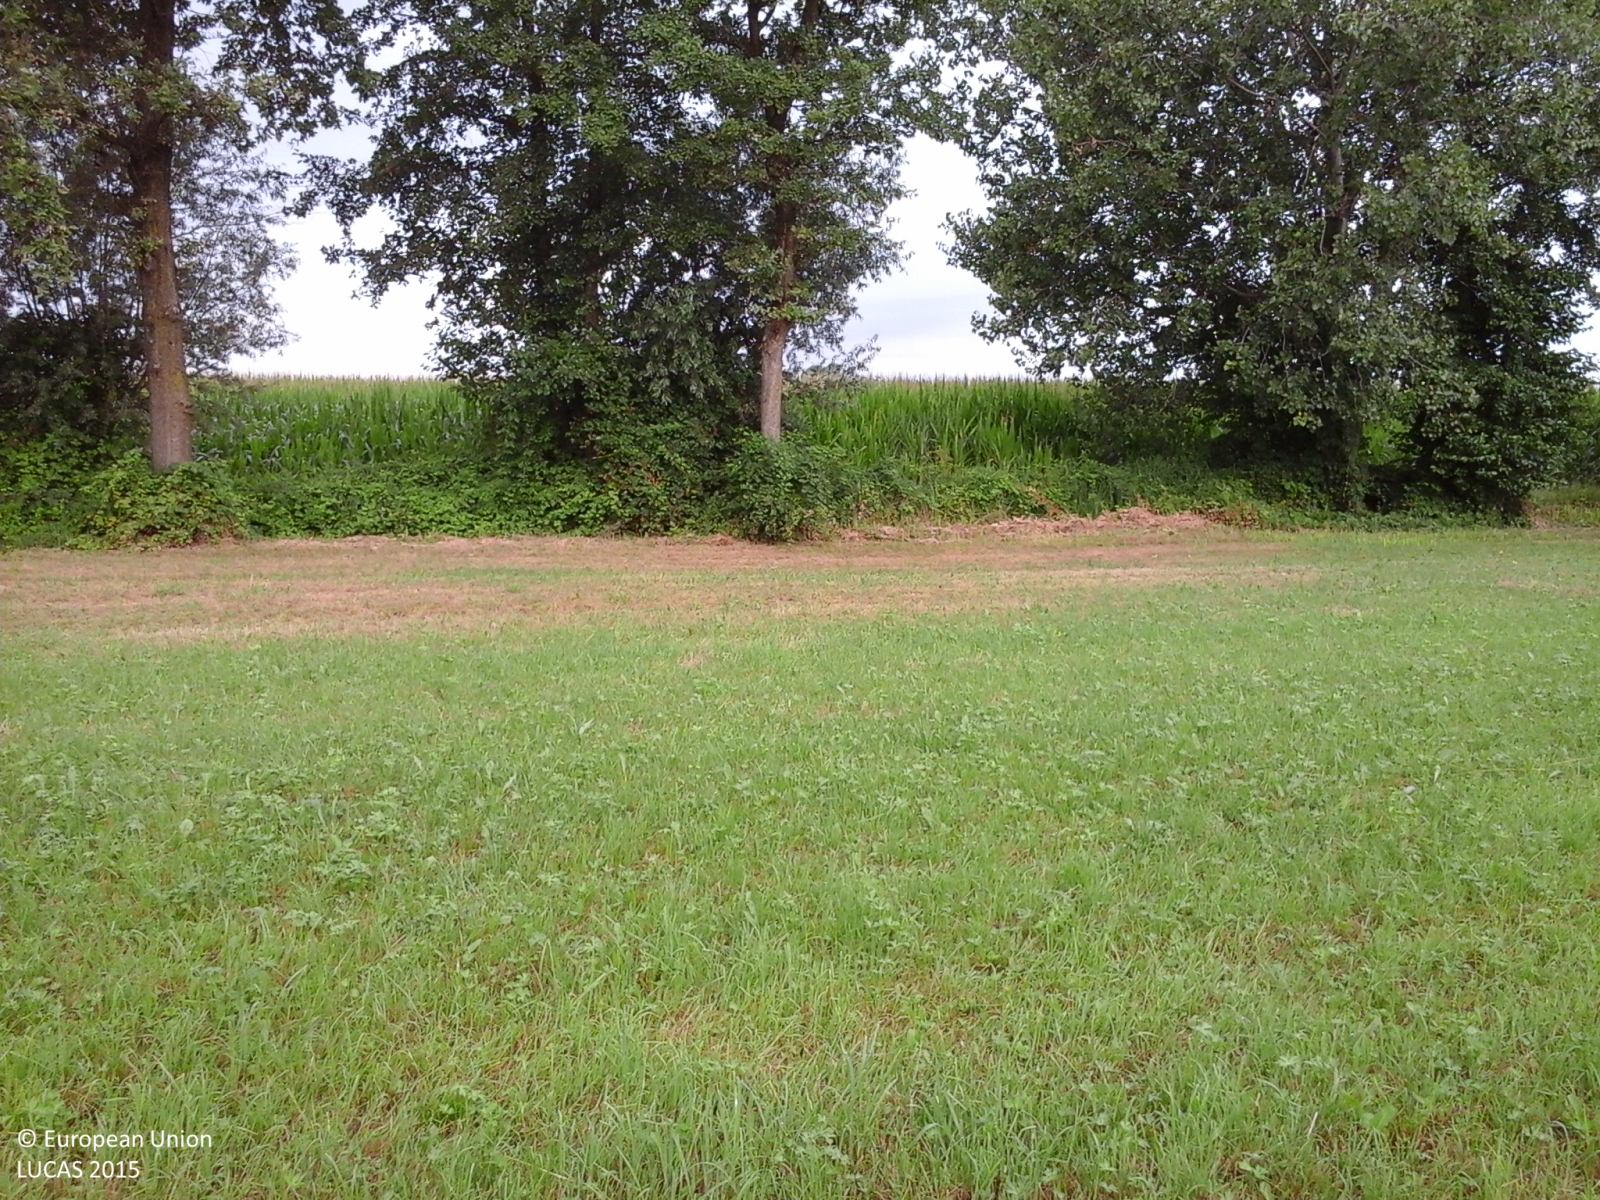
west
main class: Grassland
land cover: Grassland without tree/shrub cover
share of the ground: > 75 %
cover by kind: herbaceous plants 100 %
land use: Agriculture (excluding fallow land and kitchen gardens)
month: July
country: IT
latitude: 44.3422
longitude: 7.6594
